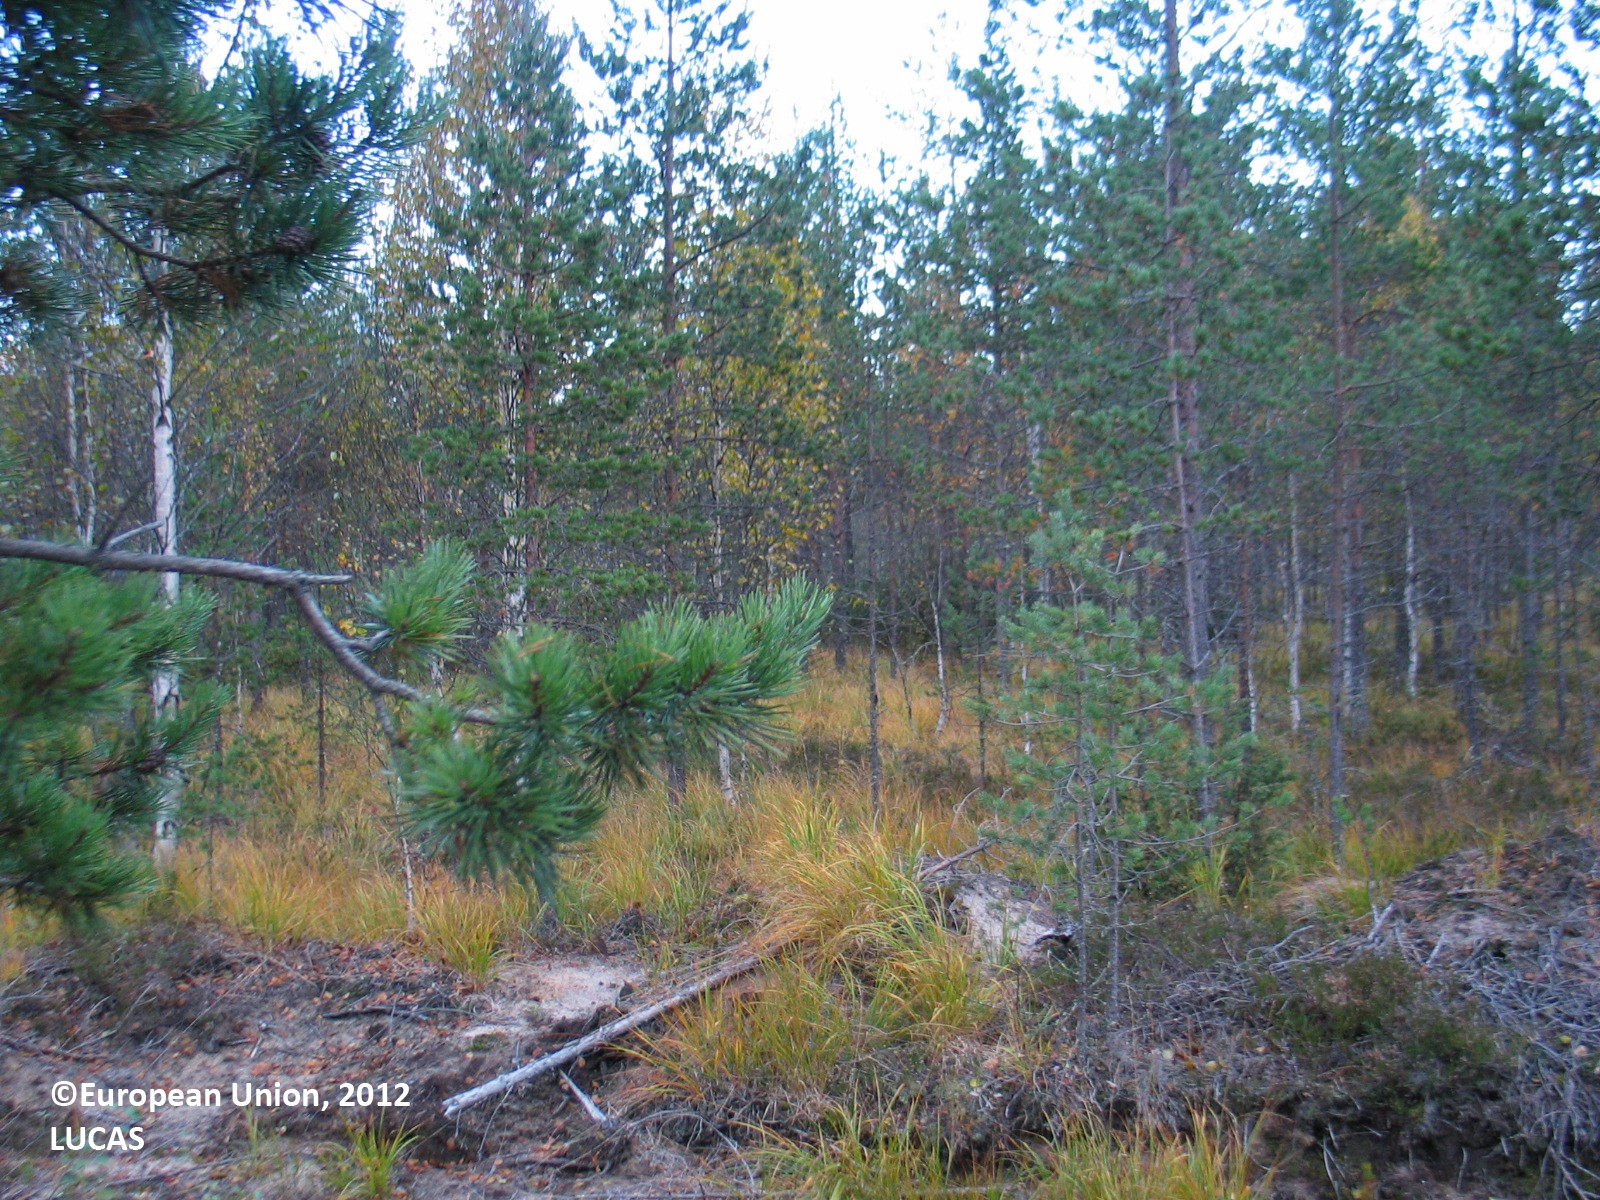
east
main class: Woodland
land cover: Pine dominated coniferous woodland
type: mire and swamp forests
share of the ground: 25 - 50 %
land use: Forestry
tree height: > 5 m
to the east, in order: Pine dominated coniferous woodland; Ditches and canals; Pine dominated coniferous woodland; Ditches and canals; Pine dominated coniferous woodland; Ditches and canals; Pine dominated coniferous woodland; Ditches and canals; Pine dominated coniferous woodland; Ditches and canals; Pine dominated coniferous woodland; Ditches and canals; Pine dominated coniferous woodland
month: September
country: FI
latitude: 65.5402
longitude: 25.6425
